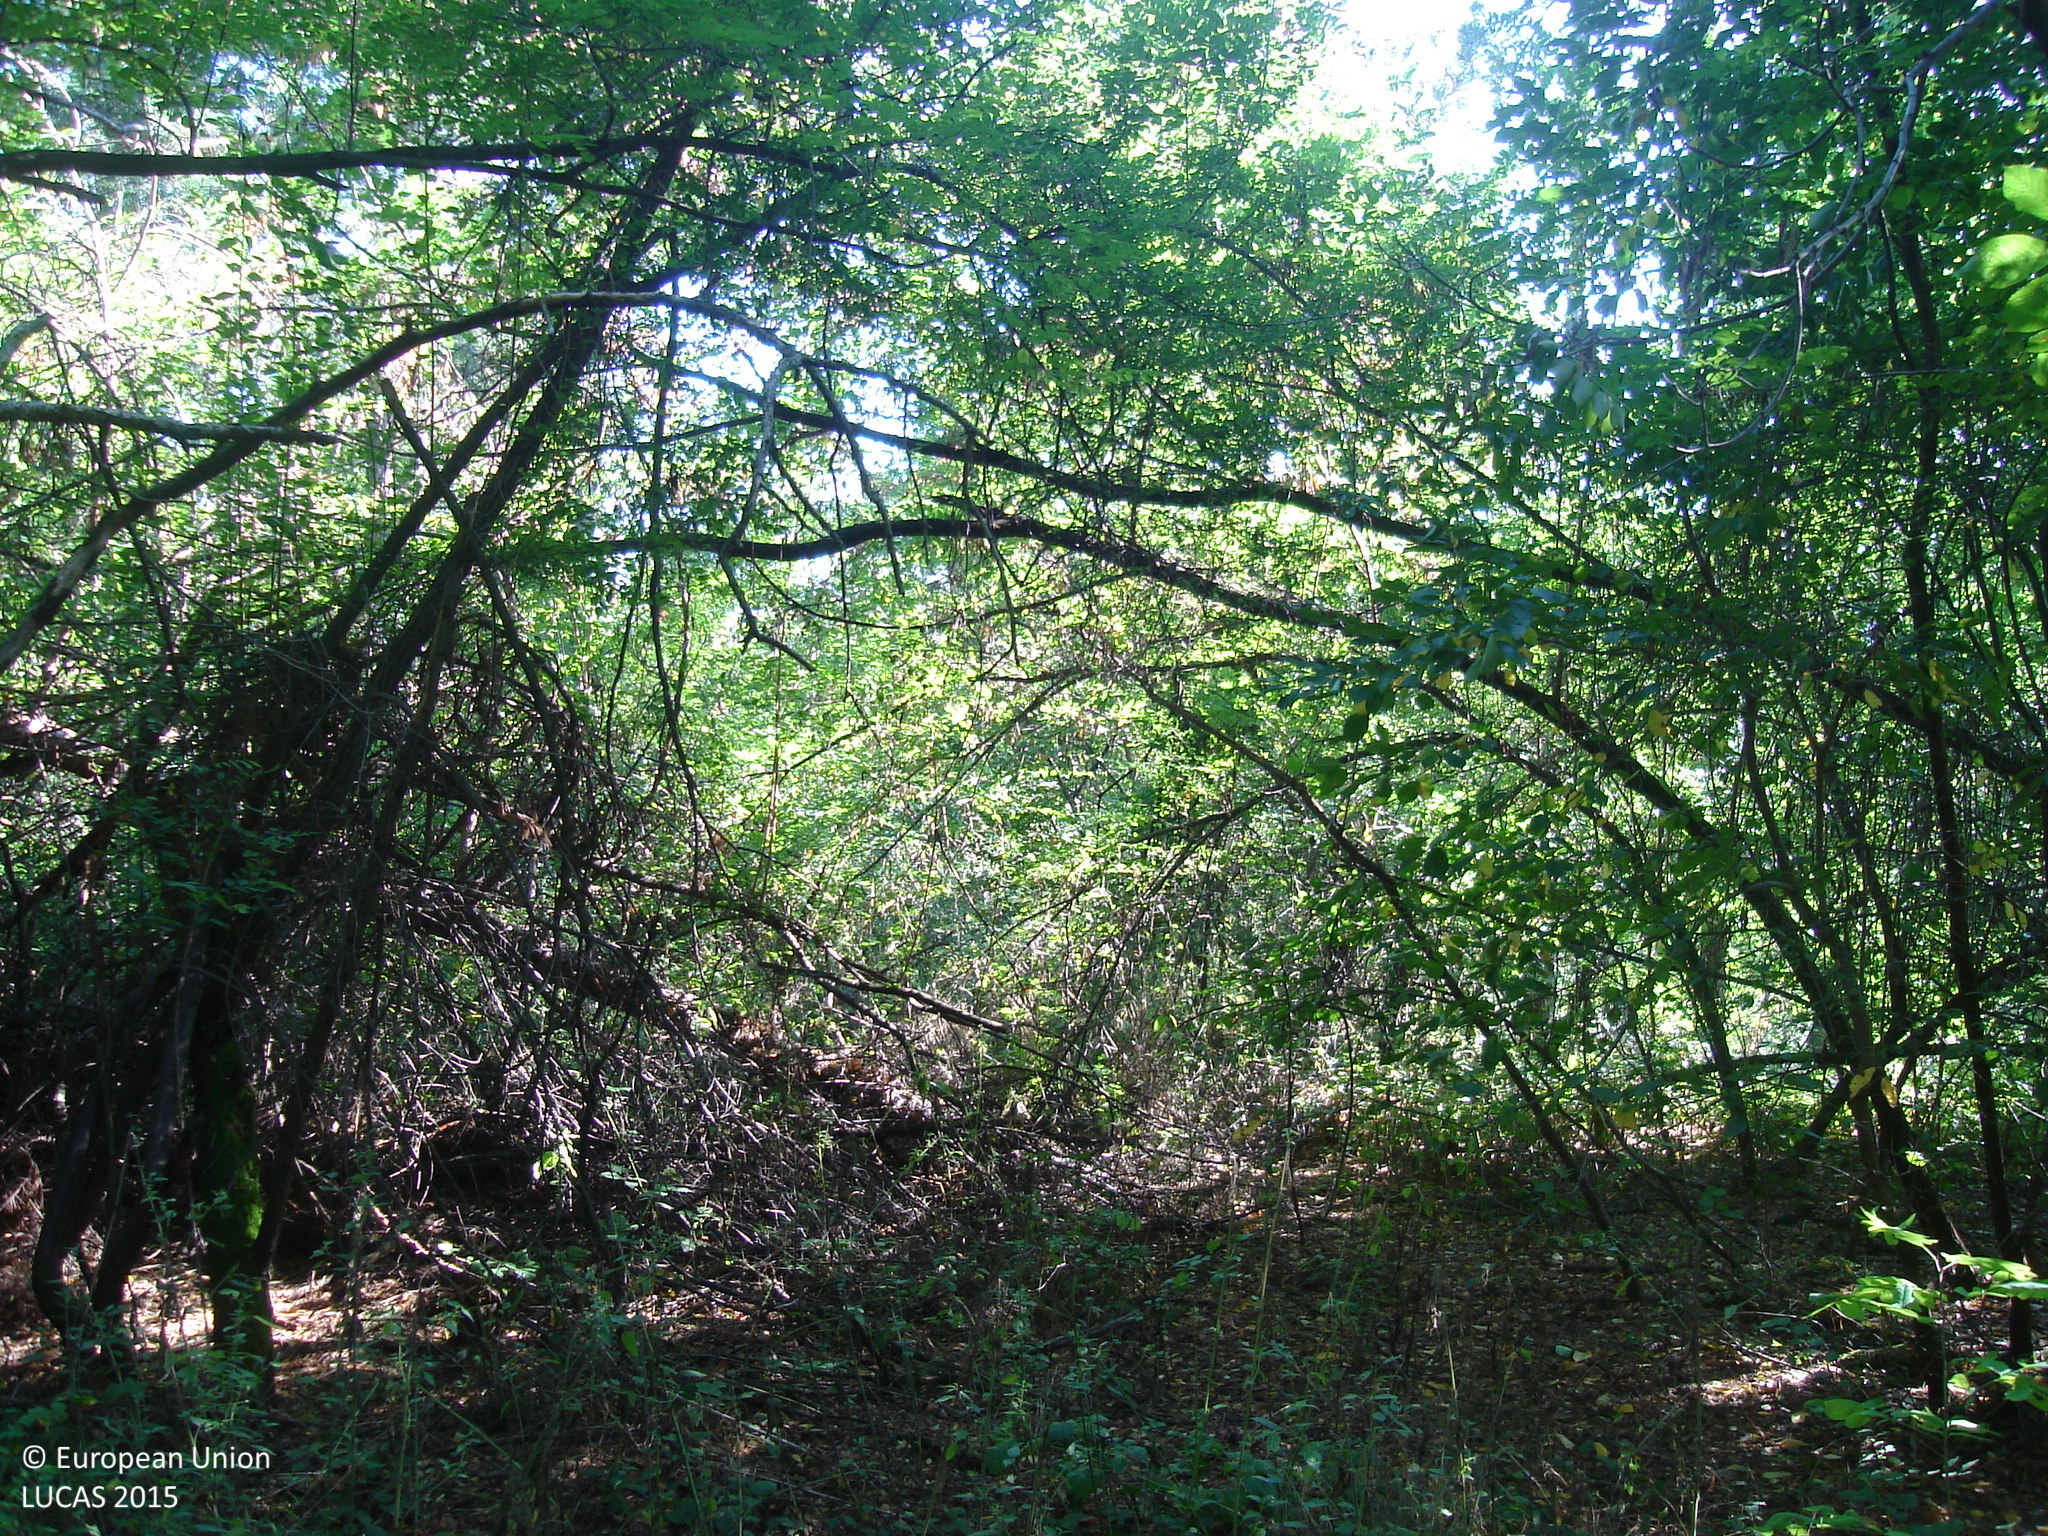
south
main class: Woodland
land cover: Broadleaved woodland
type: mesophytic deciduous forest
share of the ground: > 75 %
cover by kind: broadleaved forest trees 80 %, consolidated bare surface 15 %, shrubs 5 %
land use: Forestry
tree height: > 5 m
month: September
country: BG
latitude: 42.3648
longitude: 23.9186
